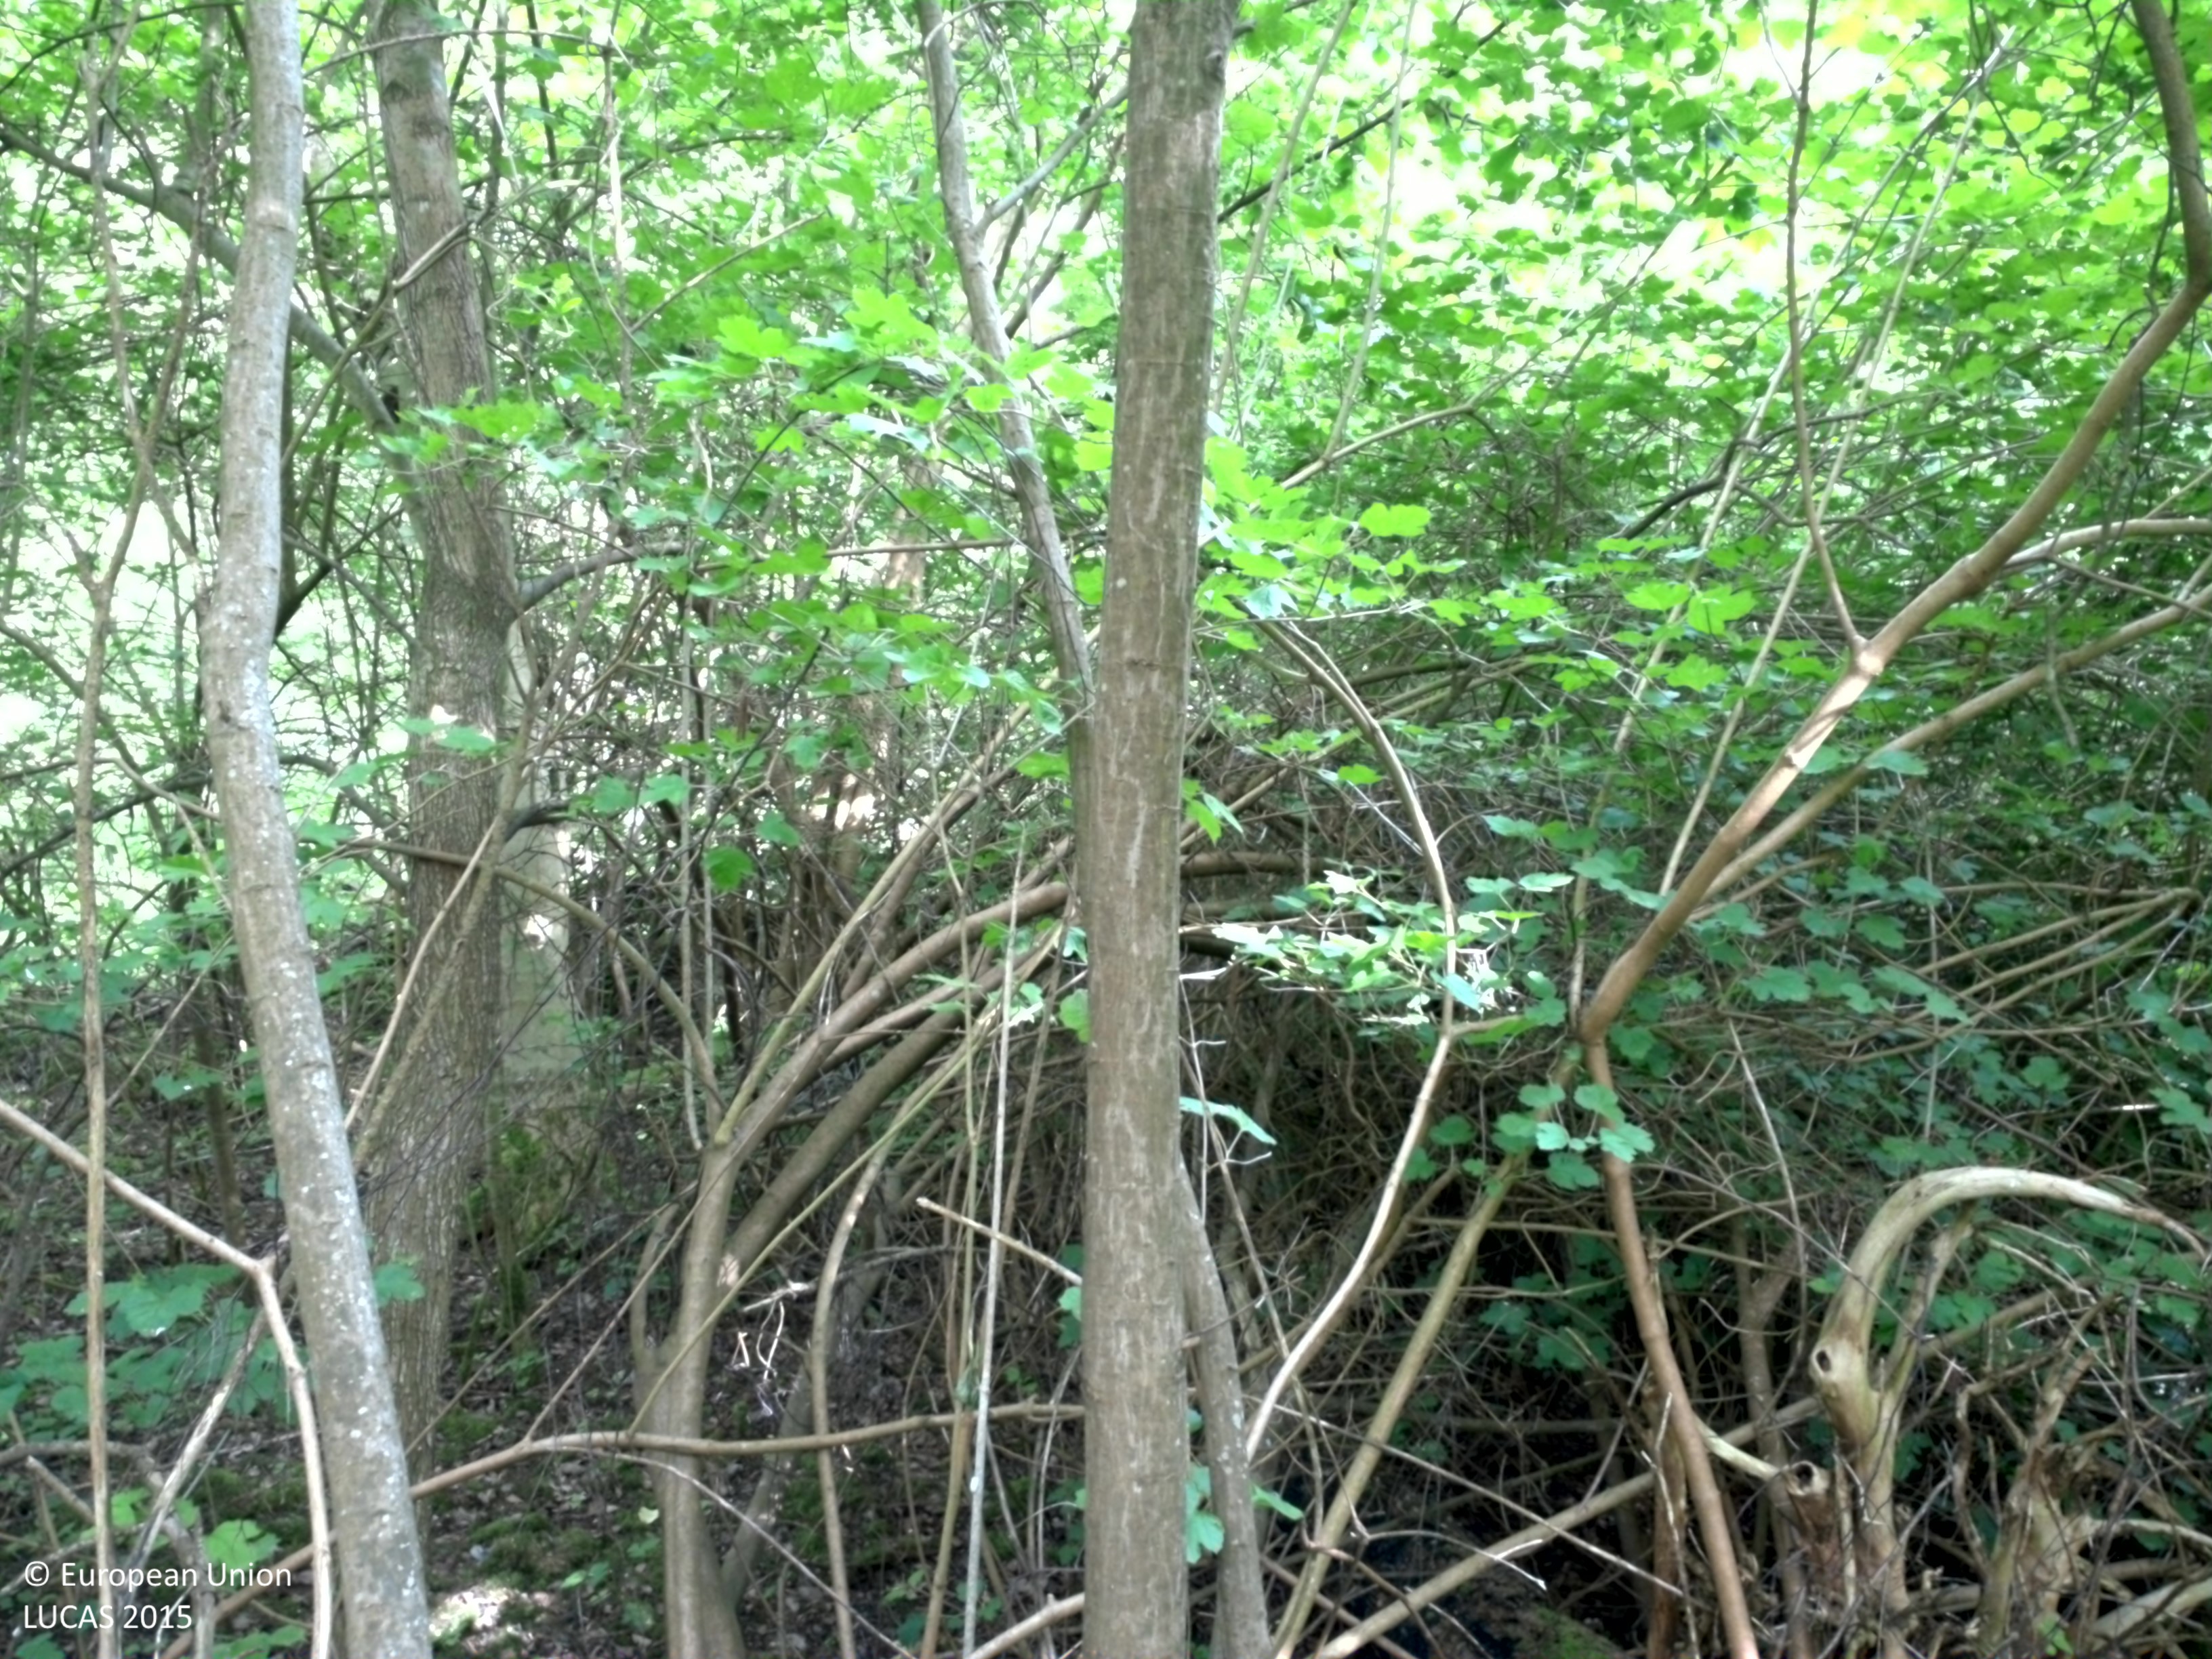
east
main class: Woodland
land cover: Broadleaved woodland
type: mesophytic deciduous forest
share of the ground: > 75 %
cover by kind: broadleaved forest trees 85 %, herbaceous plants 15 %
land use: Amenities, museums, leisure
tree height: > 5 m
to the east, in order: Broadleaved woodland; Tracks; Broadleaved woodland; Paved roads, cycling and walking lanes; Spontaneously vegetated surfaces; Ditches and canals; Other mixed woodland; Ditches and canals; Other mixed woodland
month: June
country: SE
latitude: 55.7732
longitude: 13.0745
